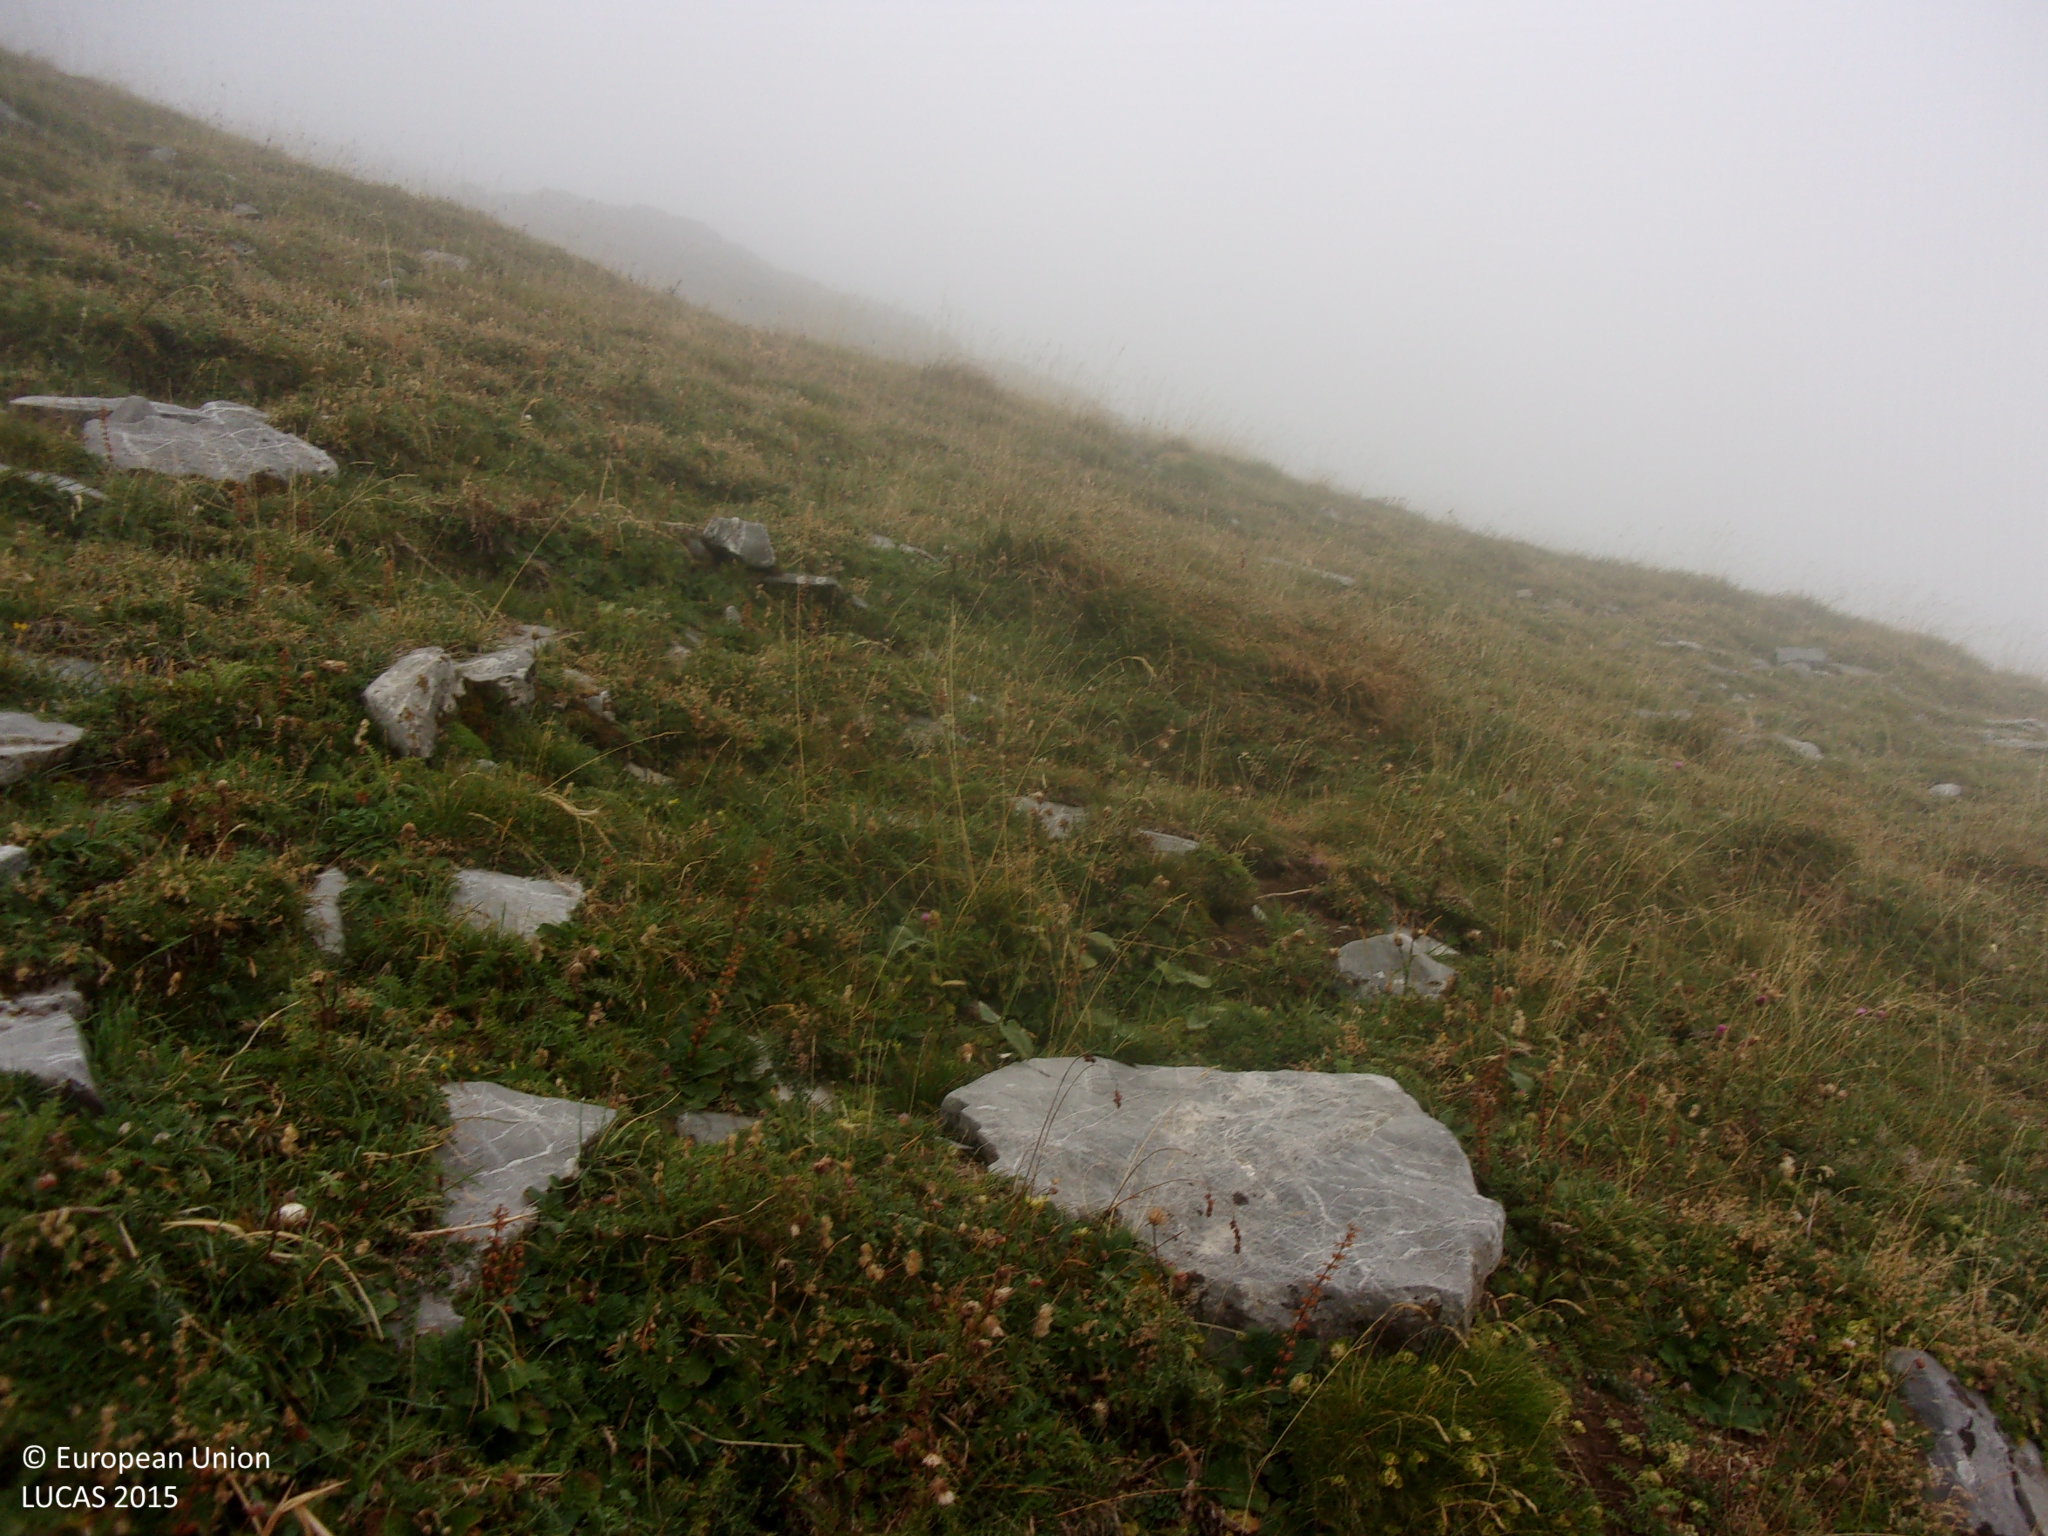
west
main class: Grassland
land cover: Grassland without tree/shrub cover
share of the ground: > 75 %
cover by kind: herbaceous plants 80 %, consolidated bare surface 20 %
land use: Semi-natural and natural areas not in use
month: August
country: ES
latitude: 42.7771
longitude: -0.5279
